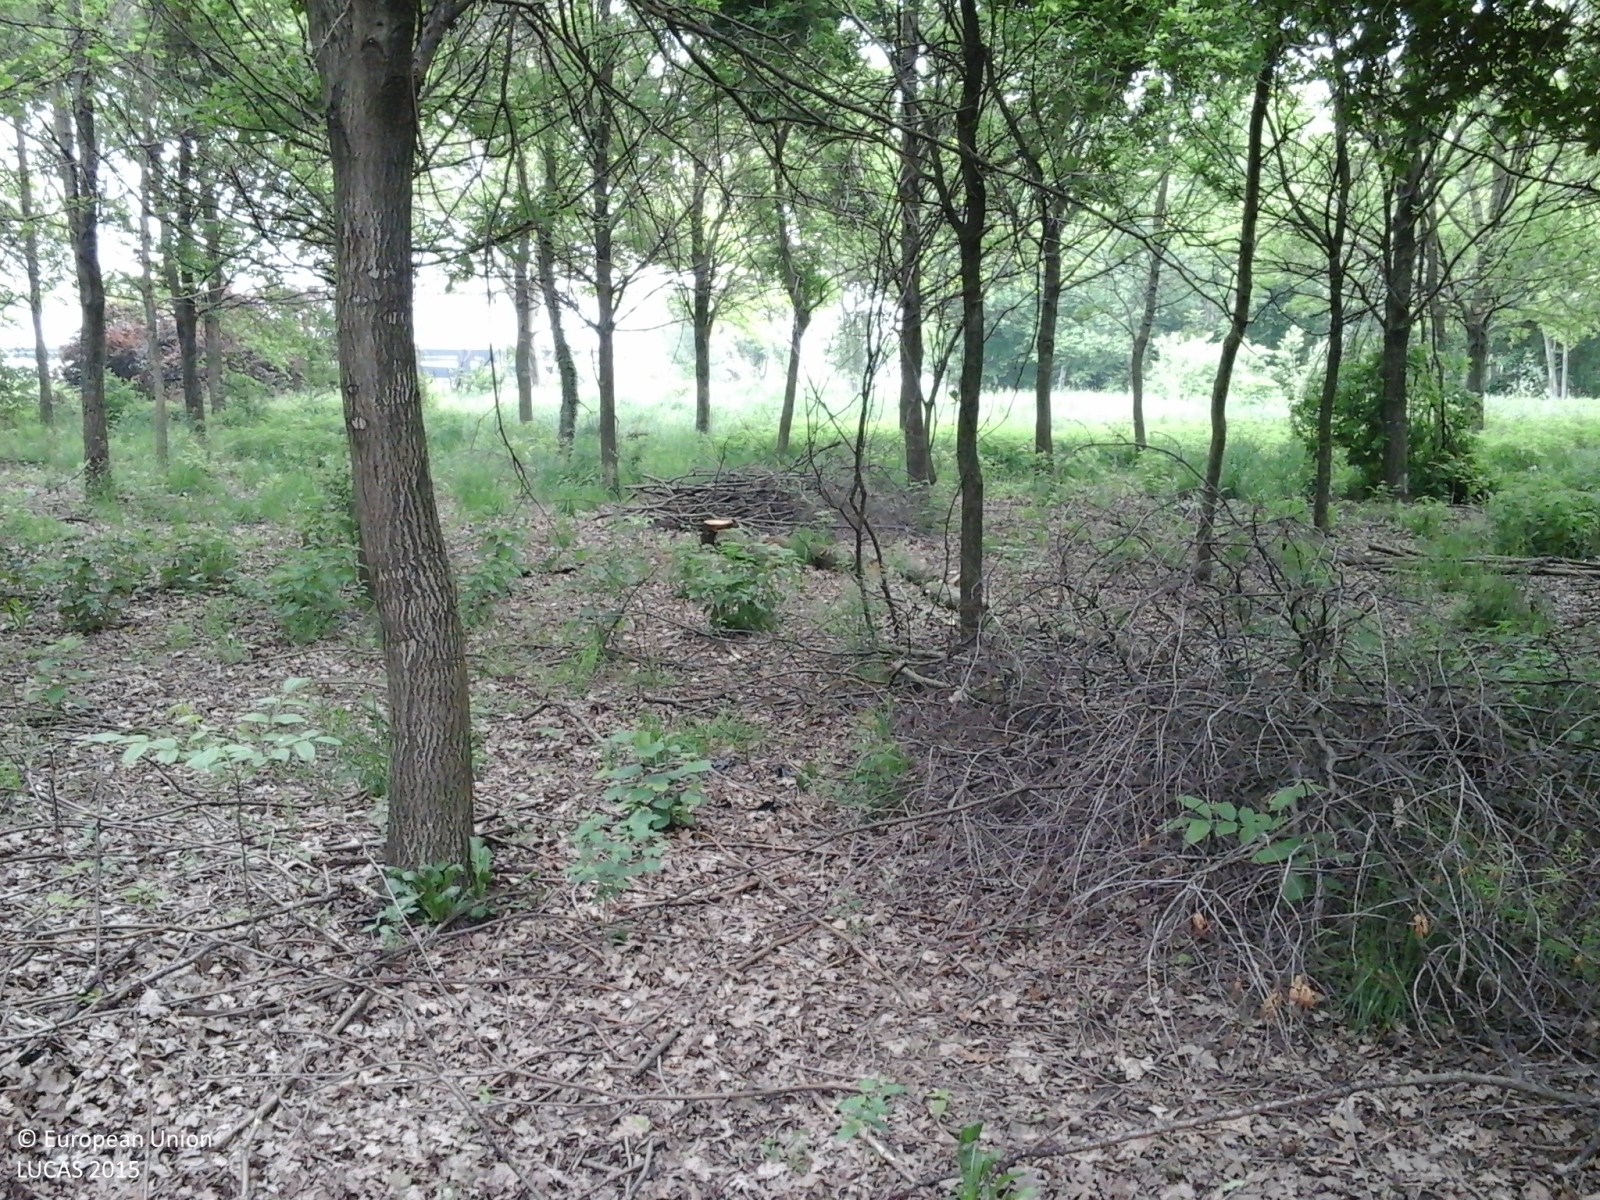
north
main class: Woodland
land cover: Broadleaved woodland
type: mesophytic deciduous forest
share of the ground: > 75 %
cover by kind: broadleaved forest trees 100 %
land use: Forestry
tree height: > 5 m
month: May
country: IT
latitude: 45.1259
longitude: 10.0634
